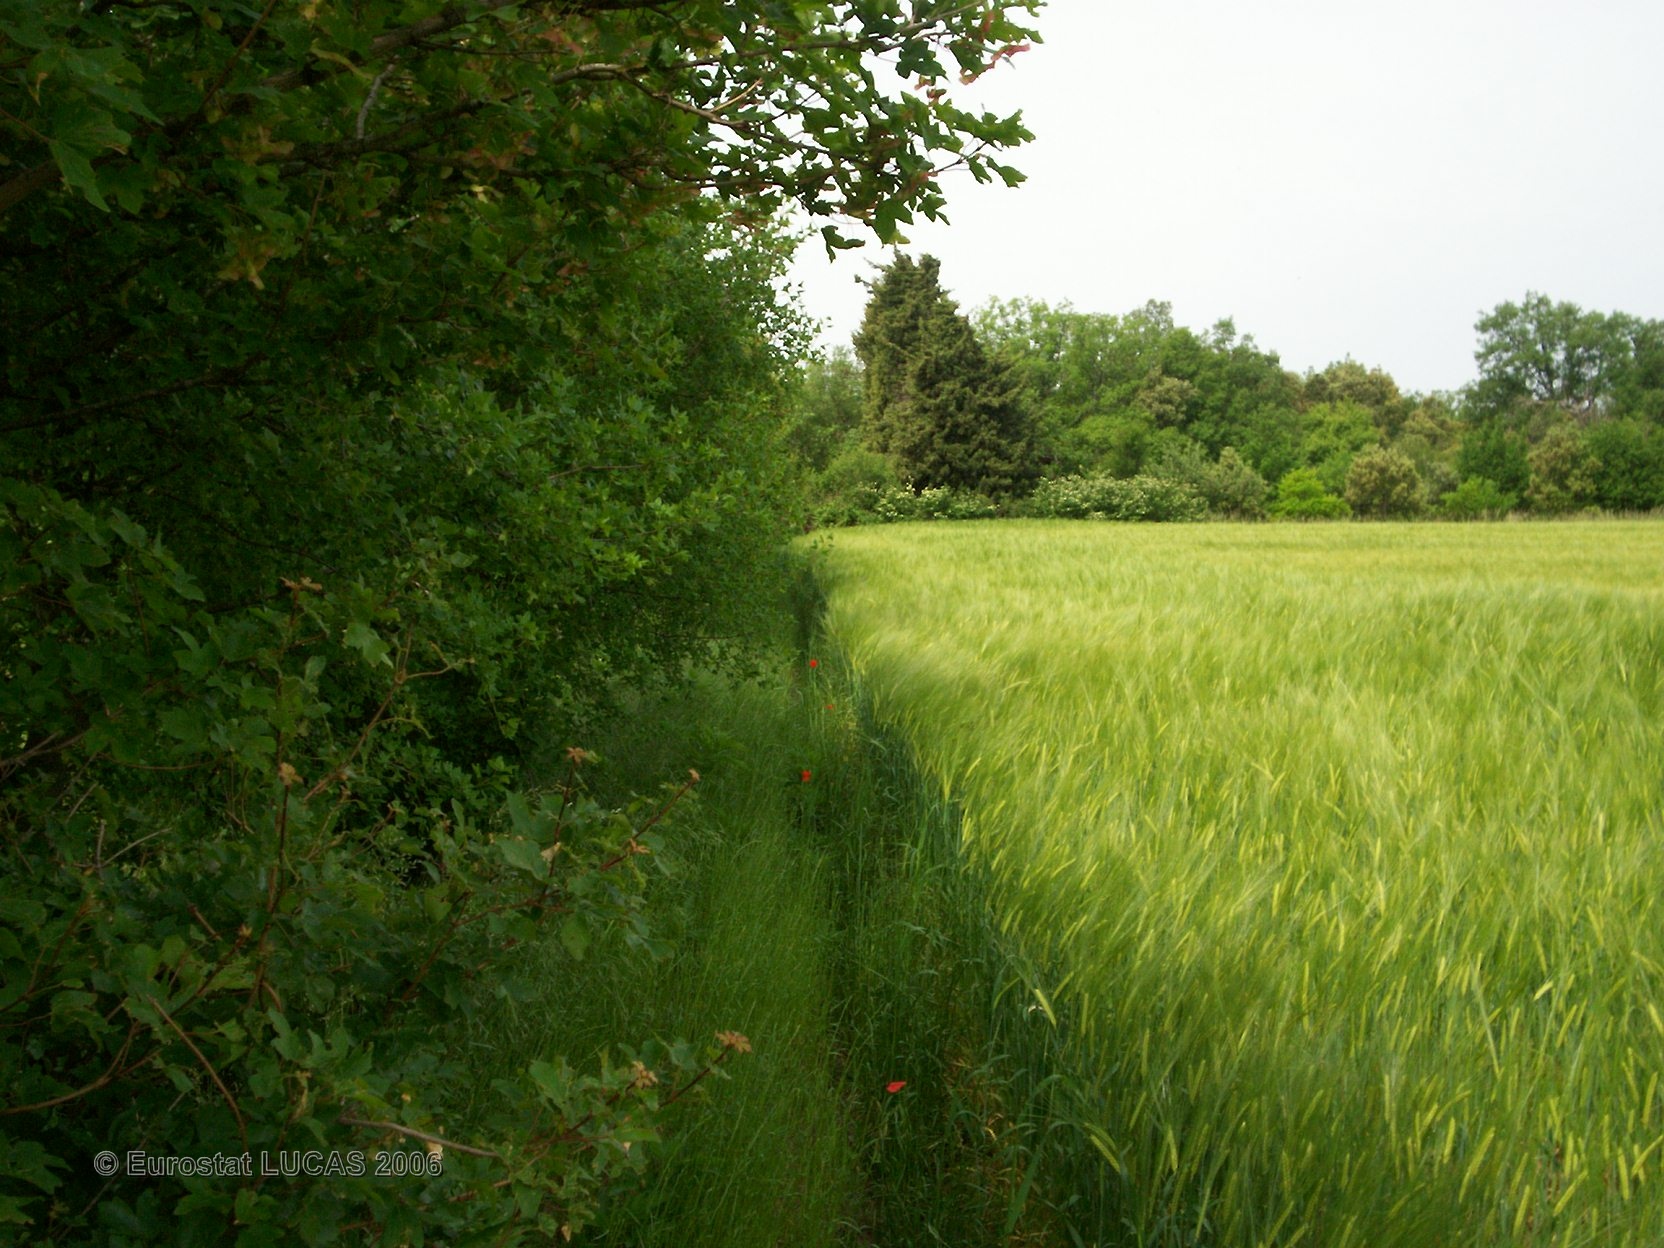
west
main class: Cropland
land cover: Barley
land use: Agriculture (excluding fallow land and kitchen gardens)
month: May
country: FR
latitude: 44.4045
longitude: 4.8716
